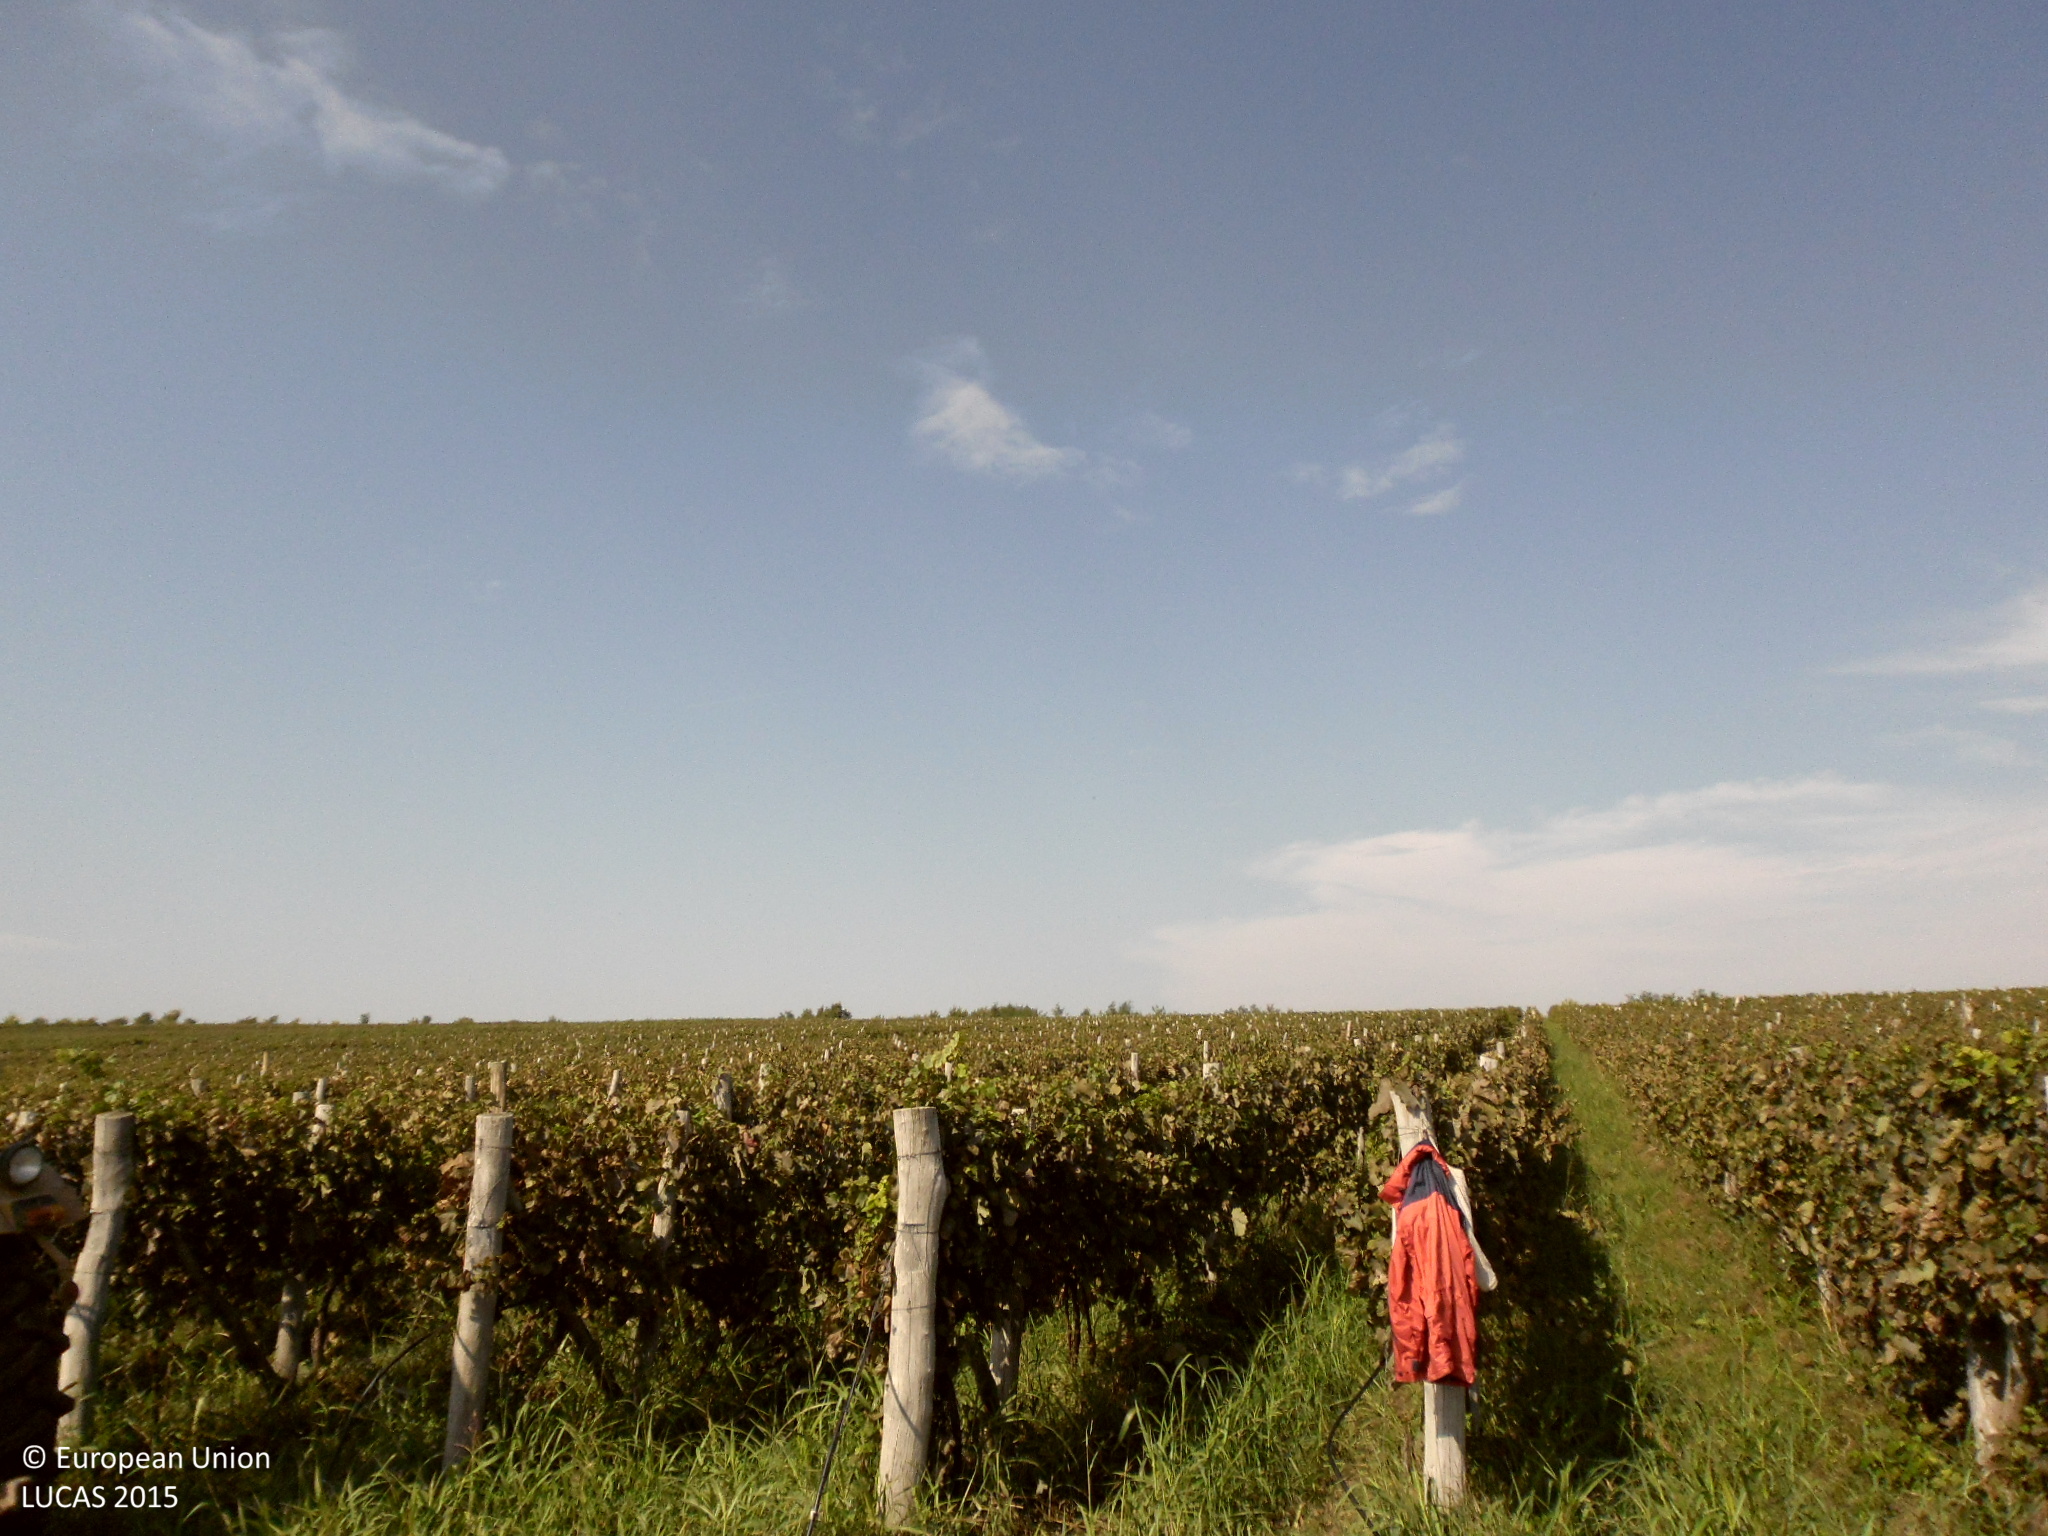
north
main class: Artificial land
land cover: Non built-up linear features
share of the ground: > 75 %
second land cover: Grassland without tree/shrub cover
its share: 25 - 50 %
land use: Road transport
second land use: Agriculture (excluding fallow land and kitchen gardens)
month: October
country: BG
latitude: 44.0135
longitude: 22.7740
